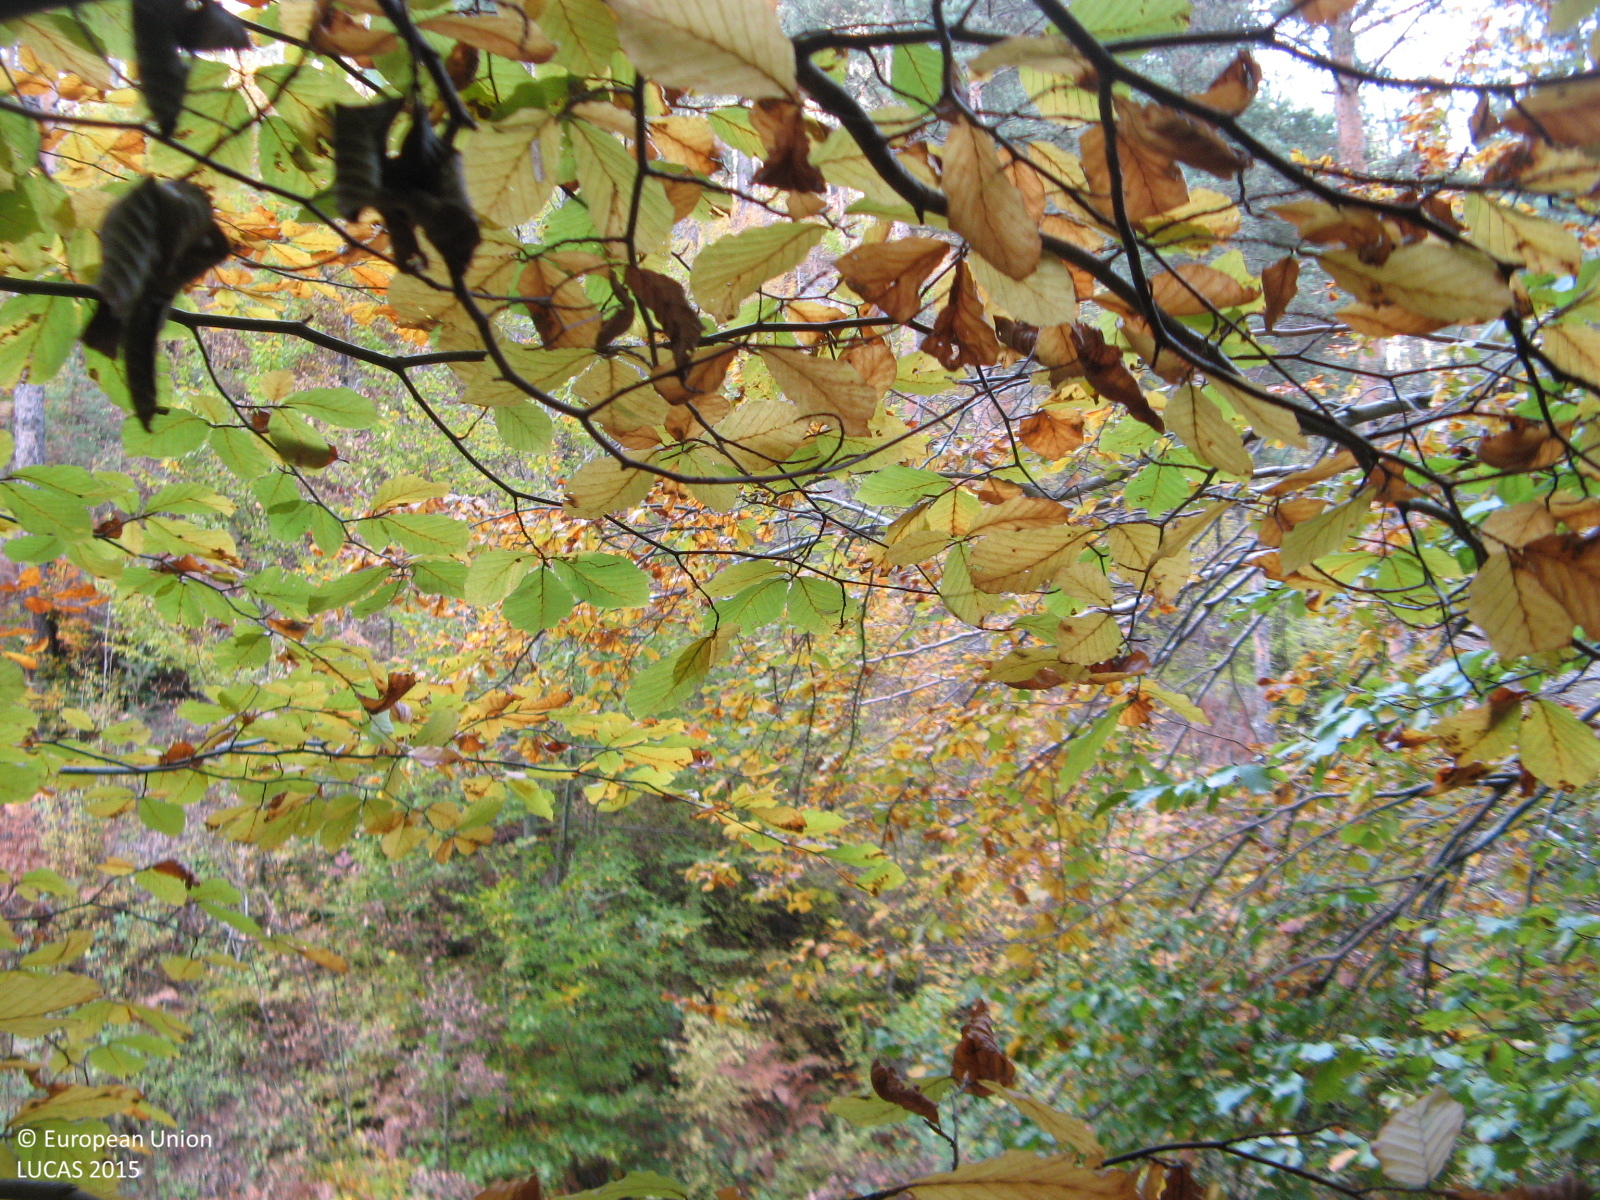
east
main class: Woodland
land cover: Broadleaved woodland
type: mountainous beech forest
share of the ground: > 75 %
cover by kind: broadleaved forest trees 95 %, unconsolidated bare surface 5 %
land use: Forestry
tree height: > 5 m
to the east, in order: Broadleaved woodland; Rivers and streams; Broadleaved woodland; Rocks and stones; Artificial constructions in urban areas
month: October
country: BG
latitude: 41.4140
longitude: 24.7945
